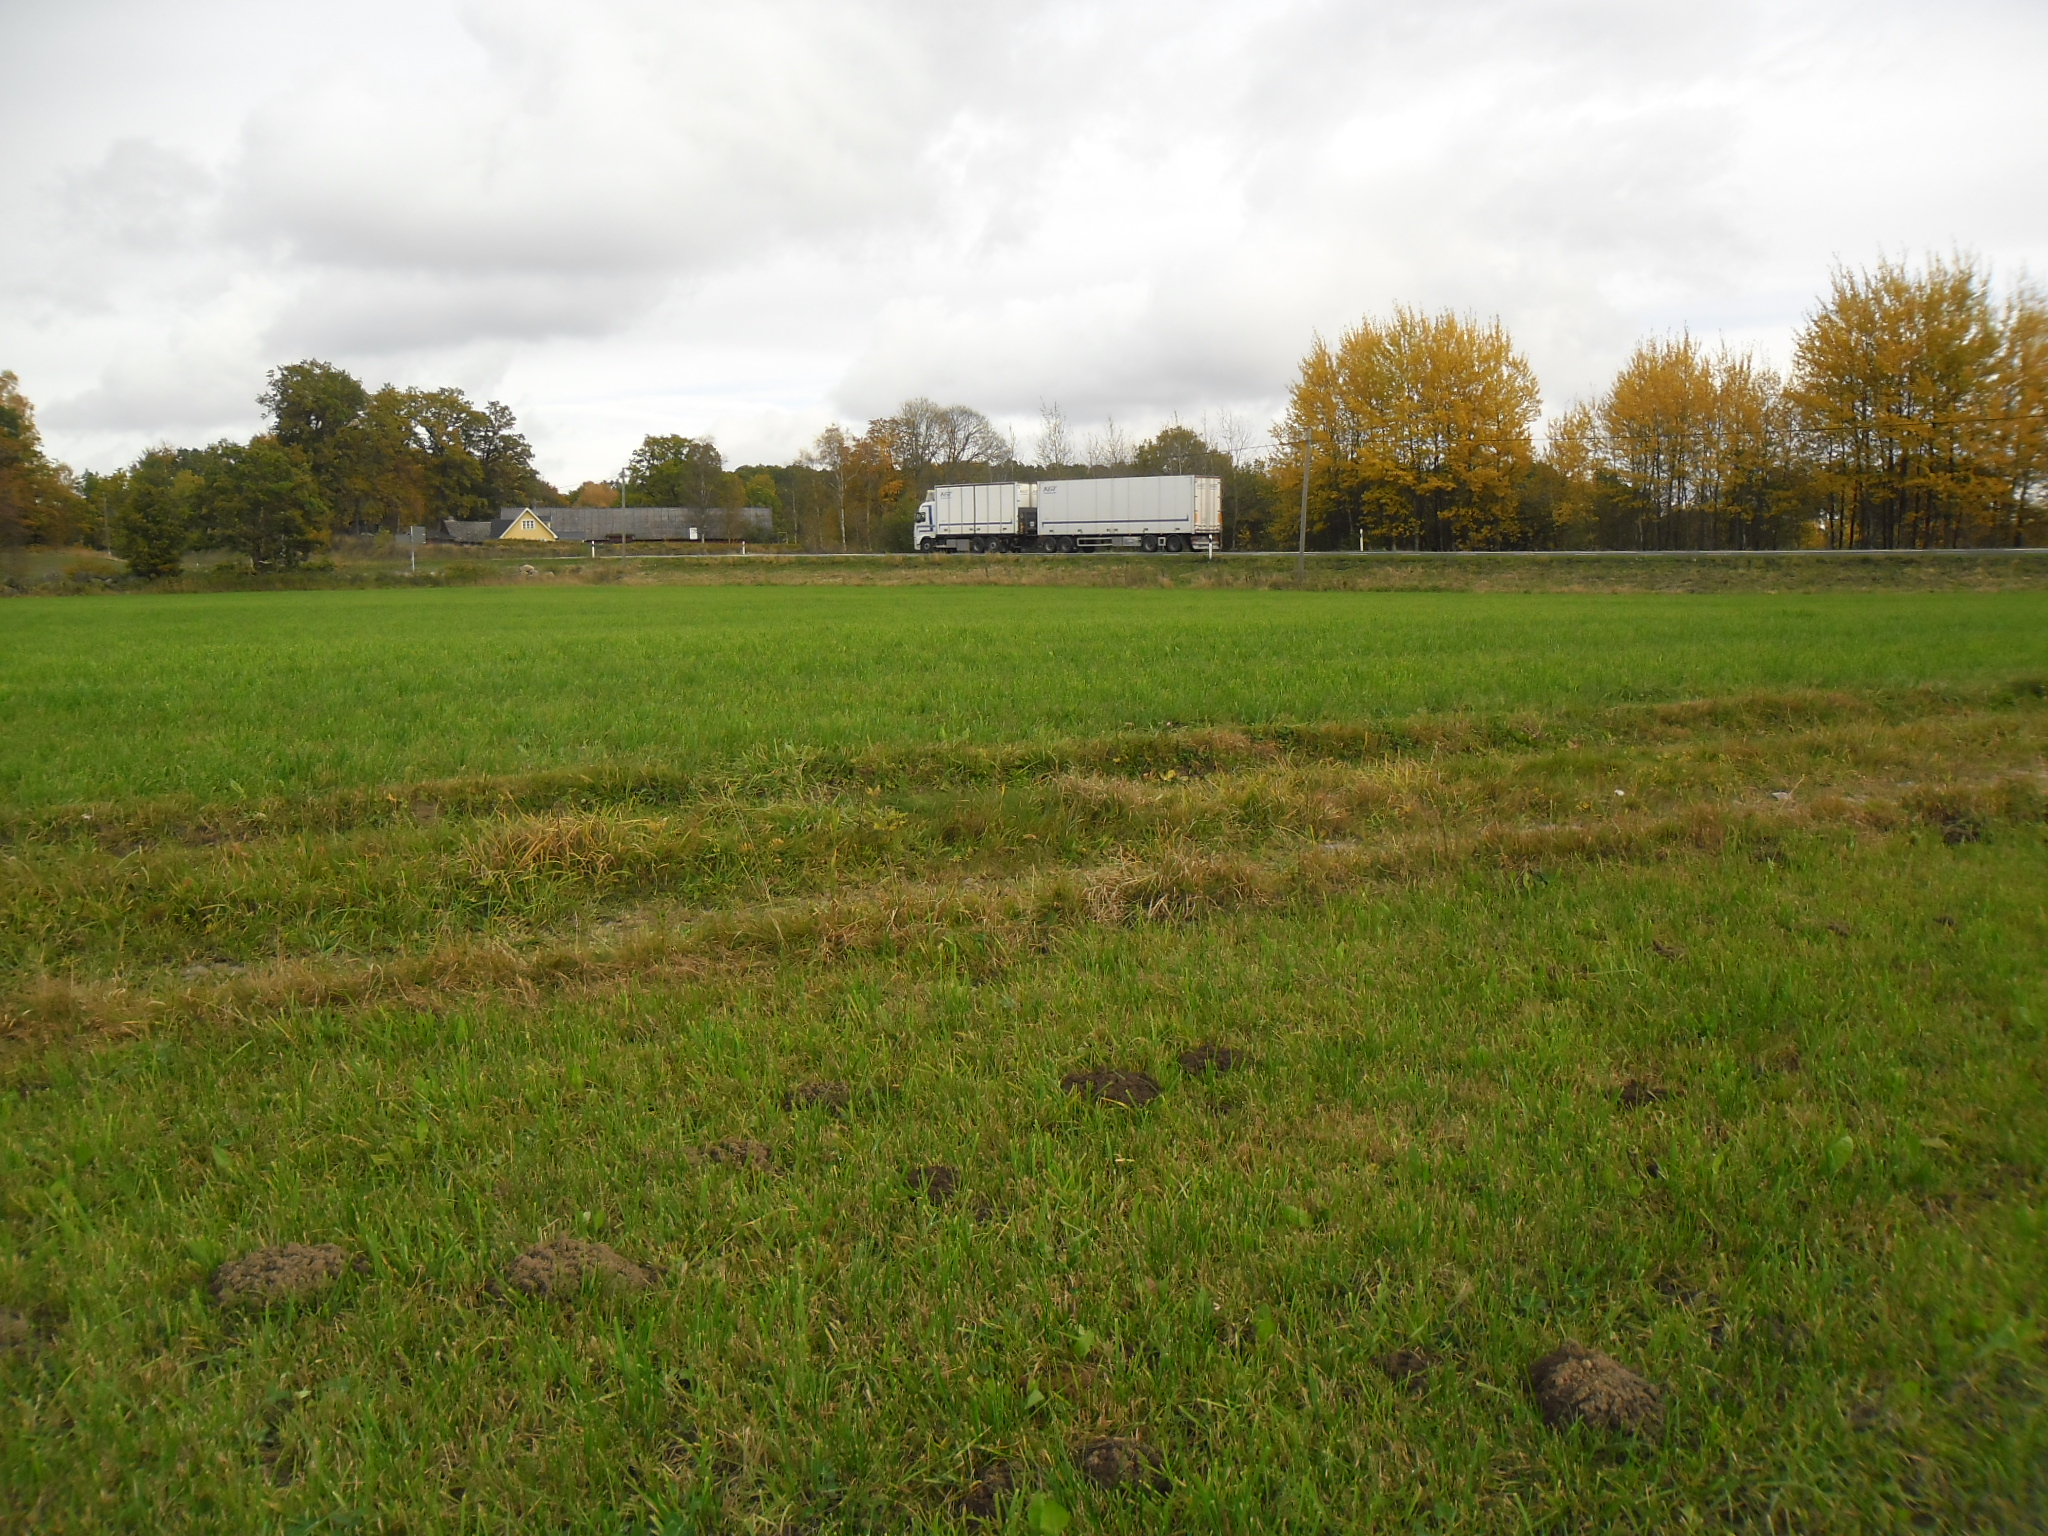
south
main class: Grassland
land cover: Grassland without tree/shrub cover
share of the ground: > 75 %
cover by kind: herbaceous plants 100 %
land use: Agriculture (excluding fallow land and kitchen gardens)
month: October
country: SE
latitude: 56.0443
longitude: 13.7059
